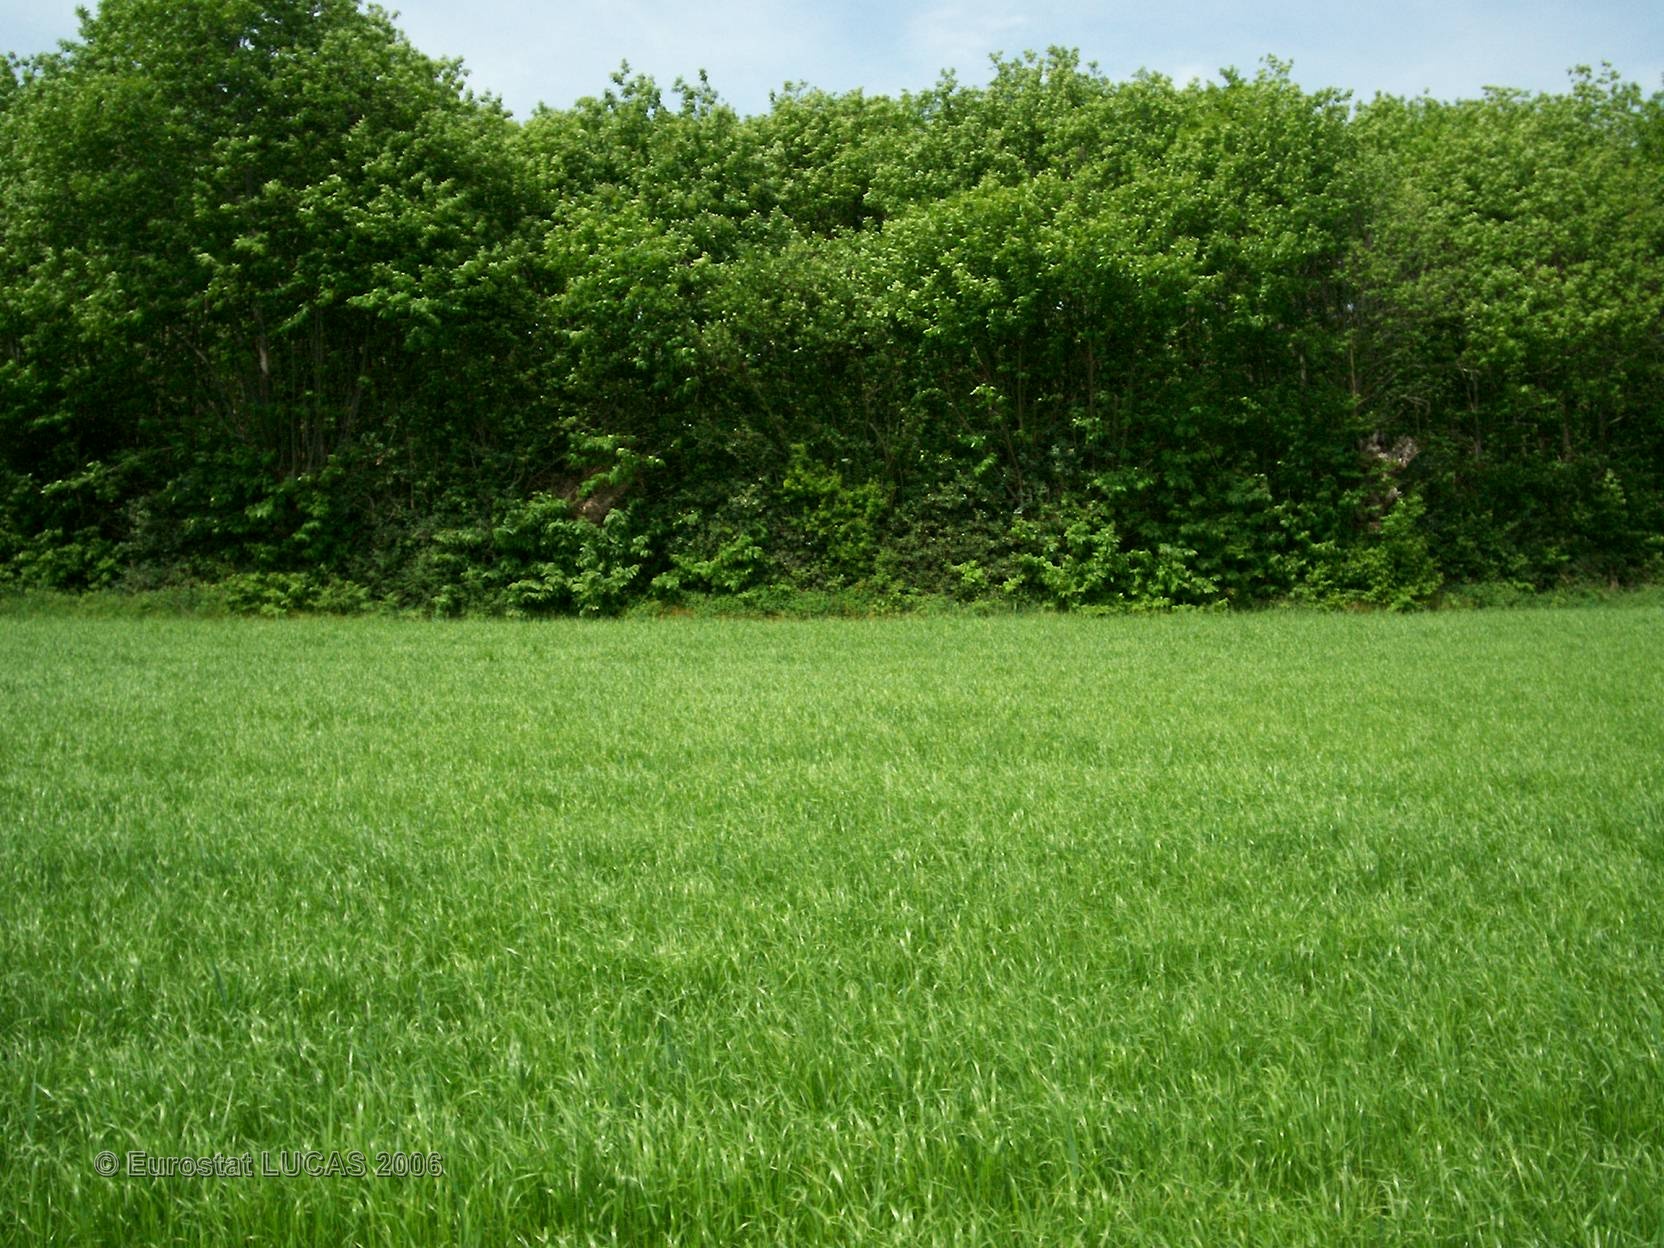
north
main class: Grassland
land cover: Grassland without tree/shrub cover
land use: Agriculture (excluding fallow land and kitchen gardens)
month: May
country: FR
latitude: 46.4876
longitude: -0.3030
